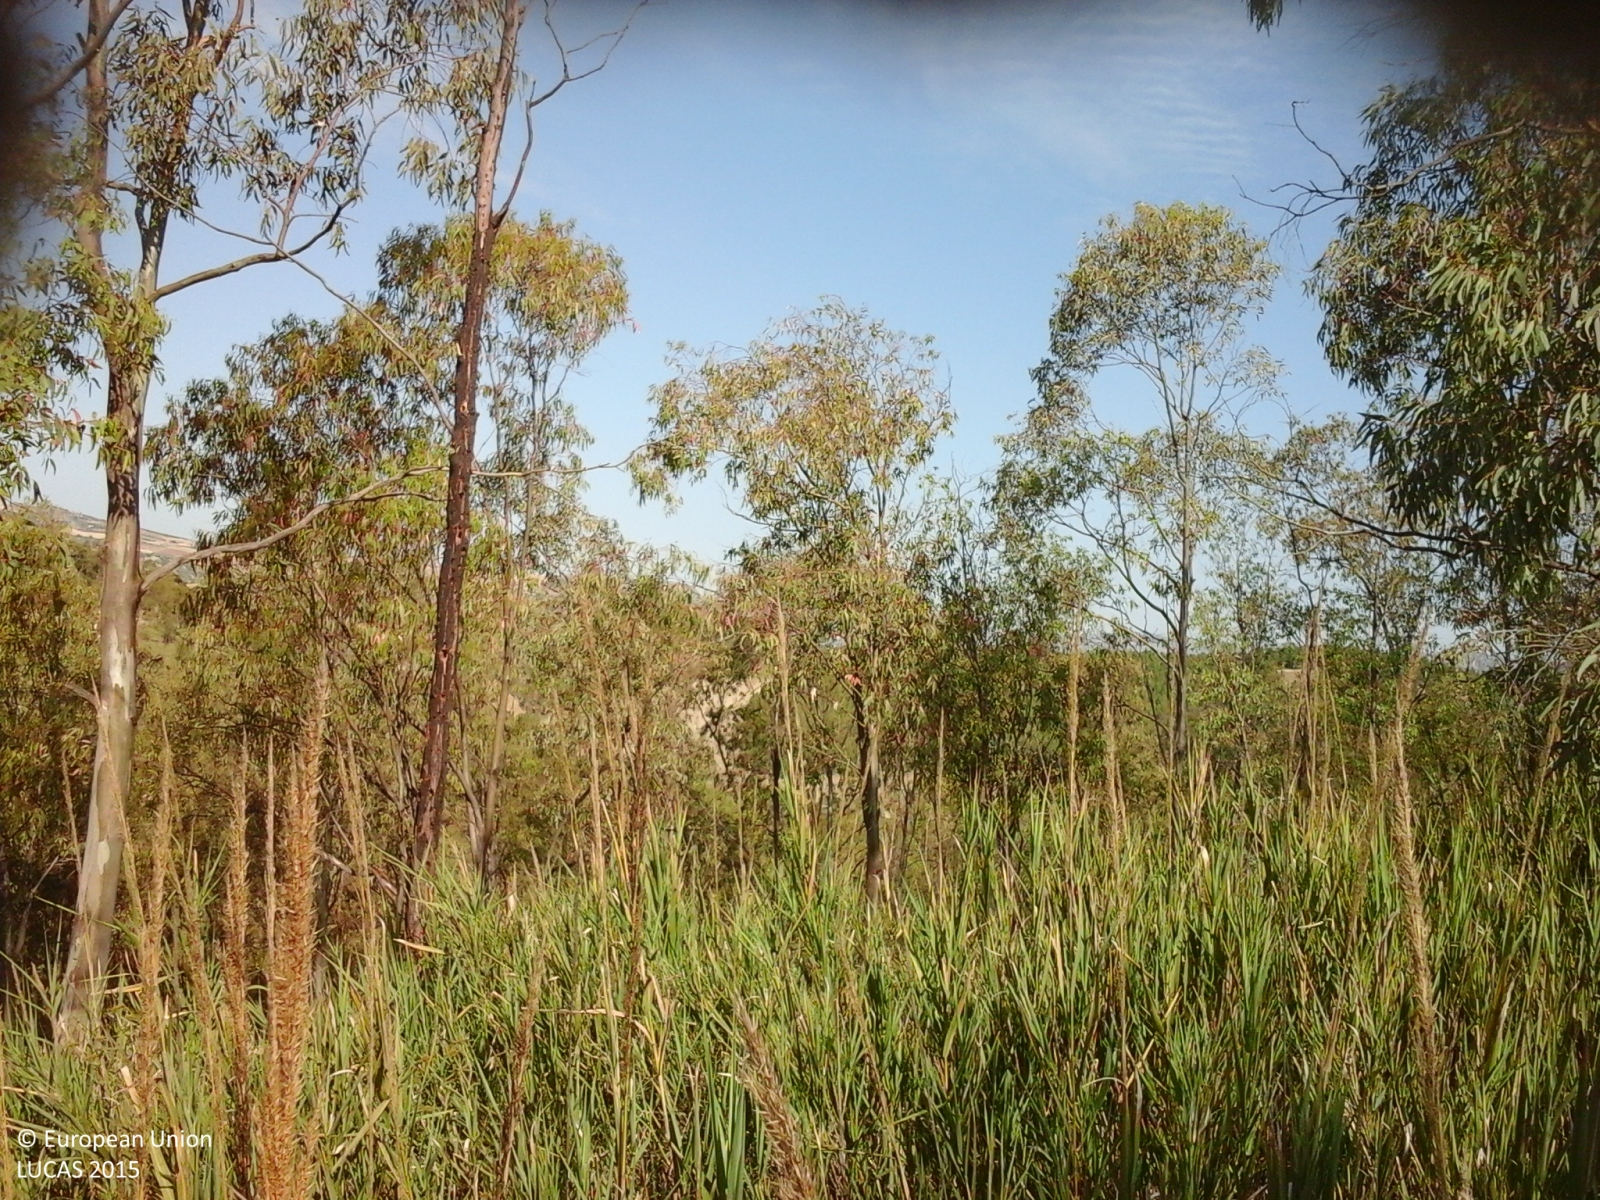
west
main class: Woodland
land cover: Broadleaved woodland
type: broadleaved evergreen forest
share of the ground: > 75 %
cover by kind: broadleaved forest trees 90 %, shrubs 5 %, herbaceous plants 5 %
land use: Forestry
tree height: > 5 m
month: June
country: IT
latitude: 37.4587
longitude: 13.6689
